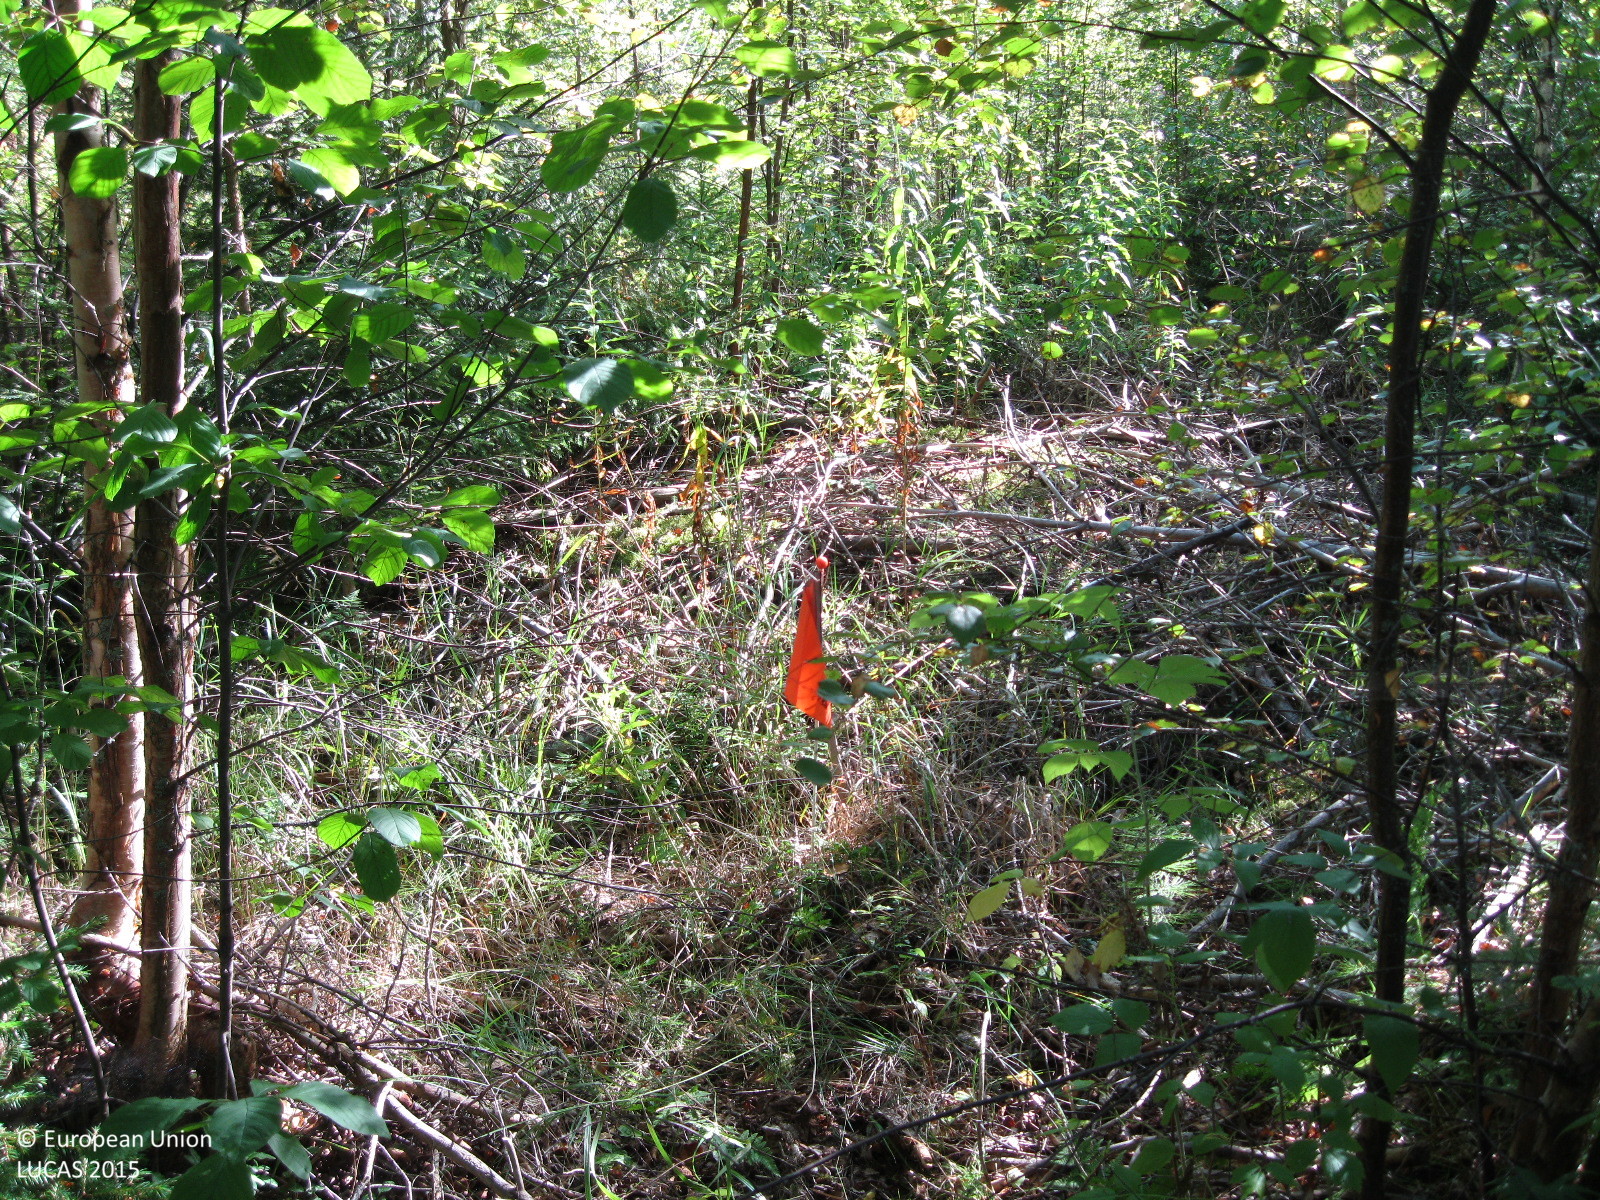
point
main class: Woodland
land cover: Pine dominated mixed woodland
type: boreal forest
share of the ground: > 75 %
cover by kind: broadleaved forest trees 70 %, coniferous forest trees 25 %, shrubs 5 %
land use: Forestry
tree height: > 5 m
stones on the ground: < 10 %
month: August
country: FI
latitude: 61.4010
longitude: 25.1134
